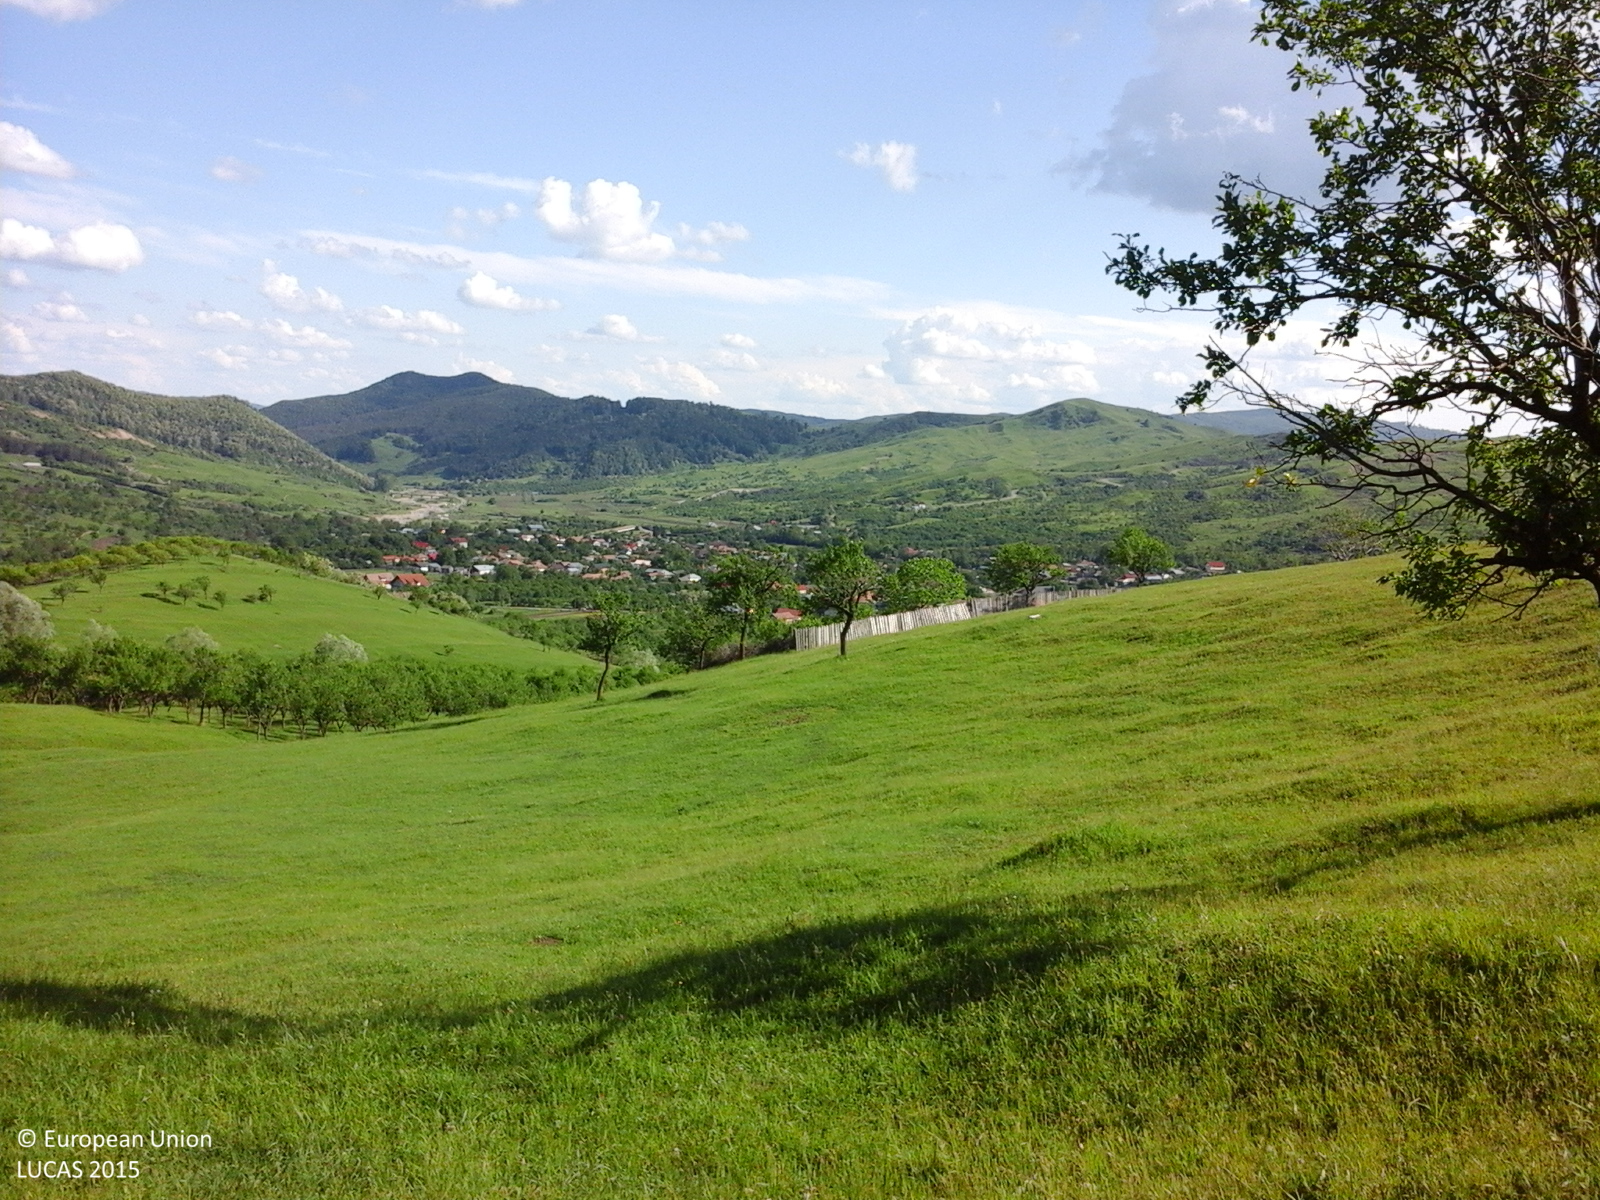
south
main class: Grassland
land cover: Grassland with sparse tree/shrub cover
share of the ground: > 75 %
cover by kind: herbaceous plants 95 %, broadleaved forest trees 5 %
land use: Agriculture (excluding fallow land and kitchen gardens)
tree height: > 5 m
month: May
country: RO
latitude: 45.3605
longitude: 26.2150
